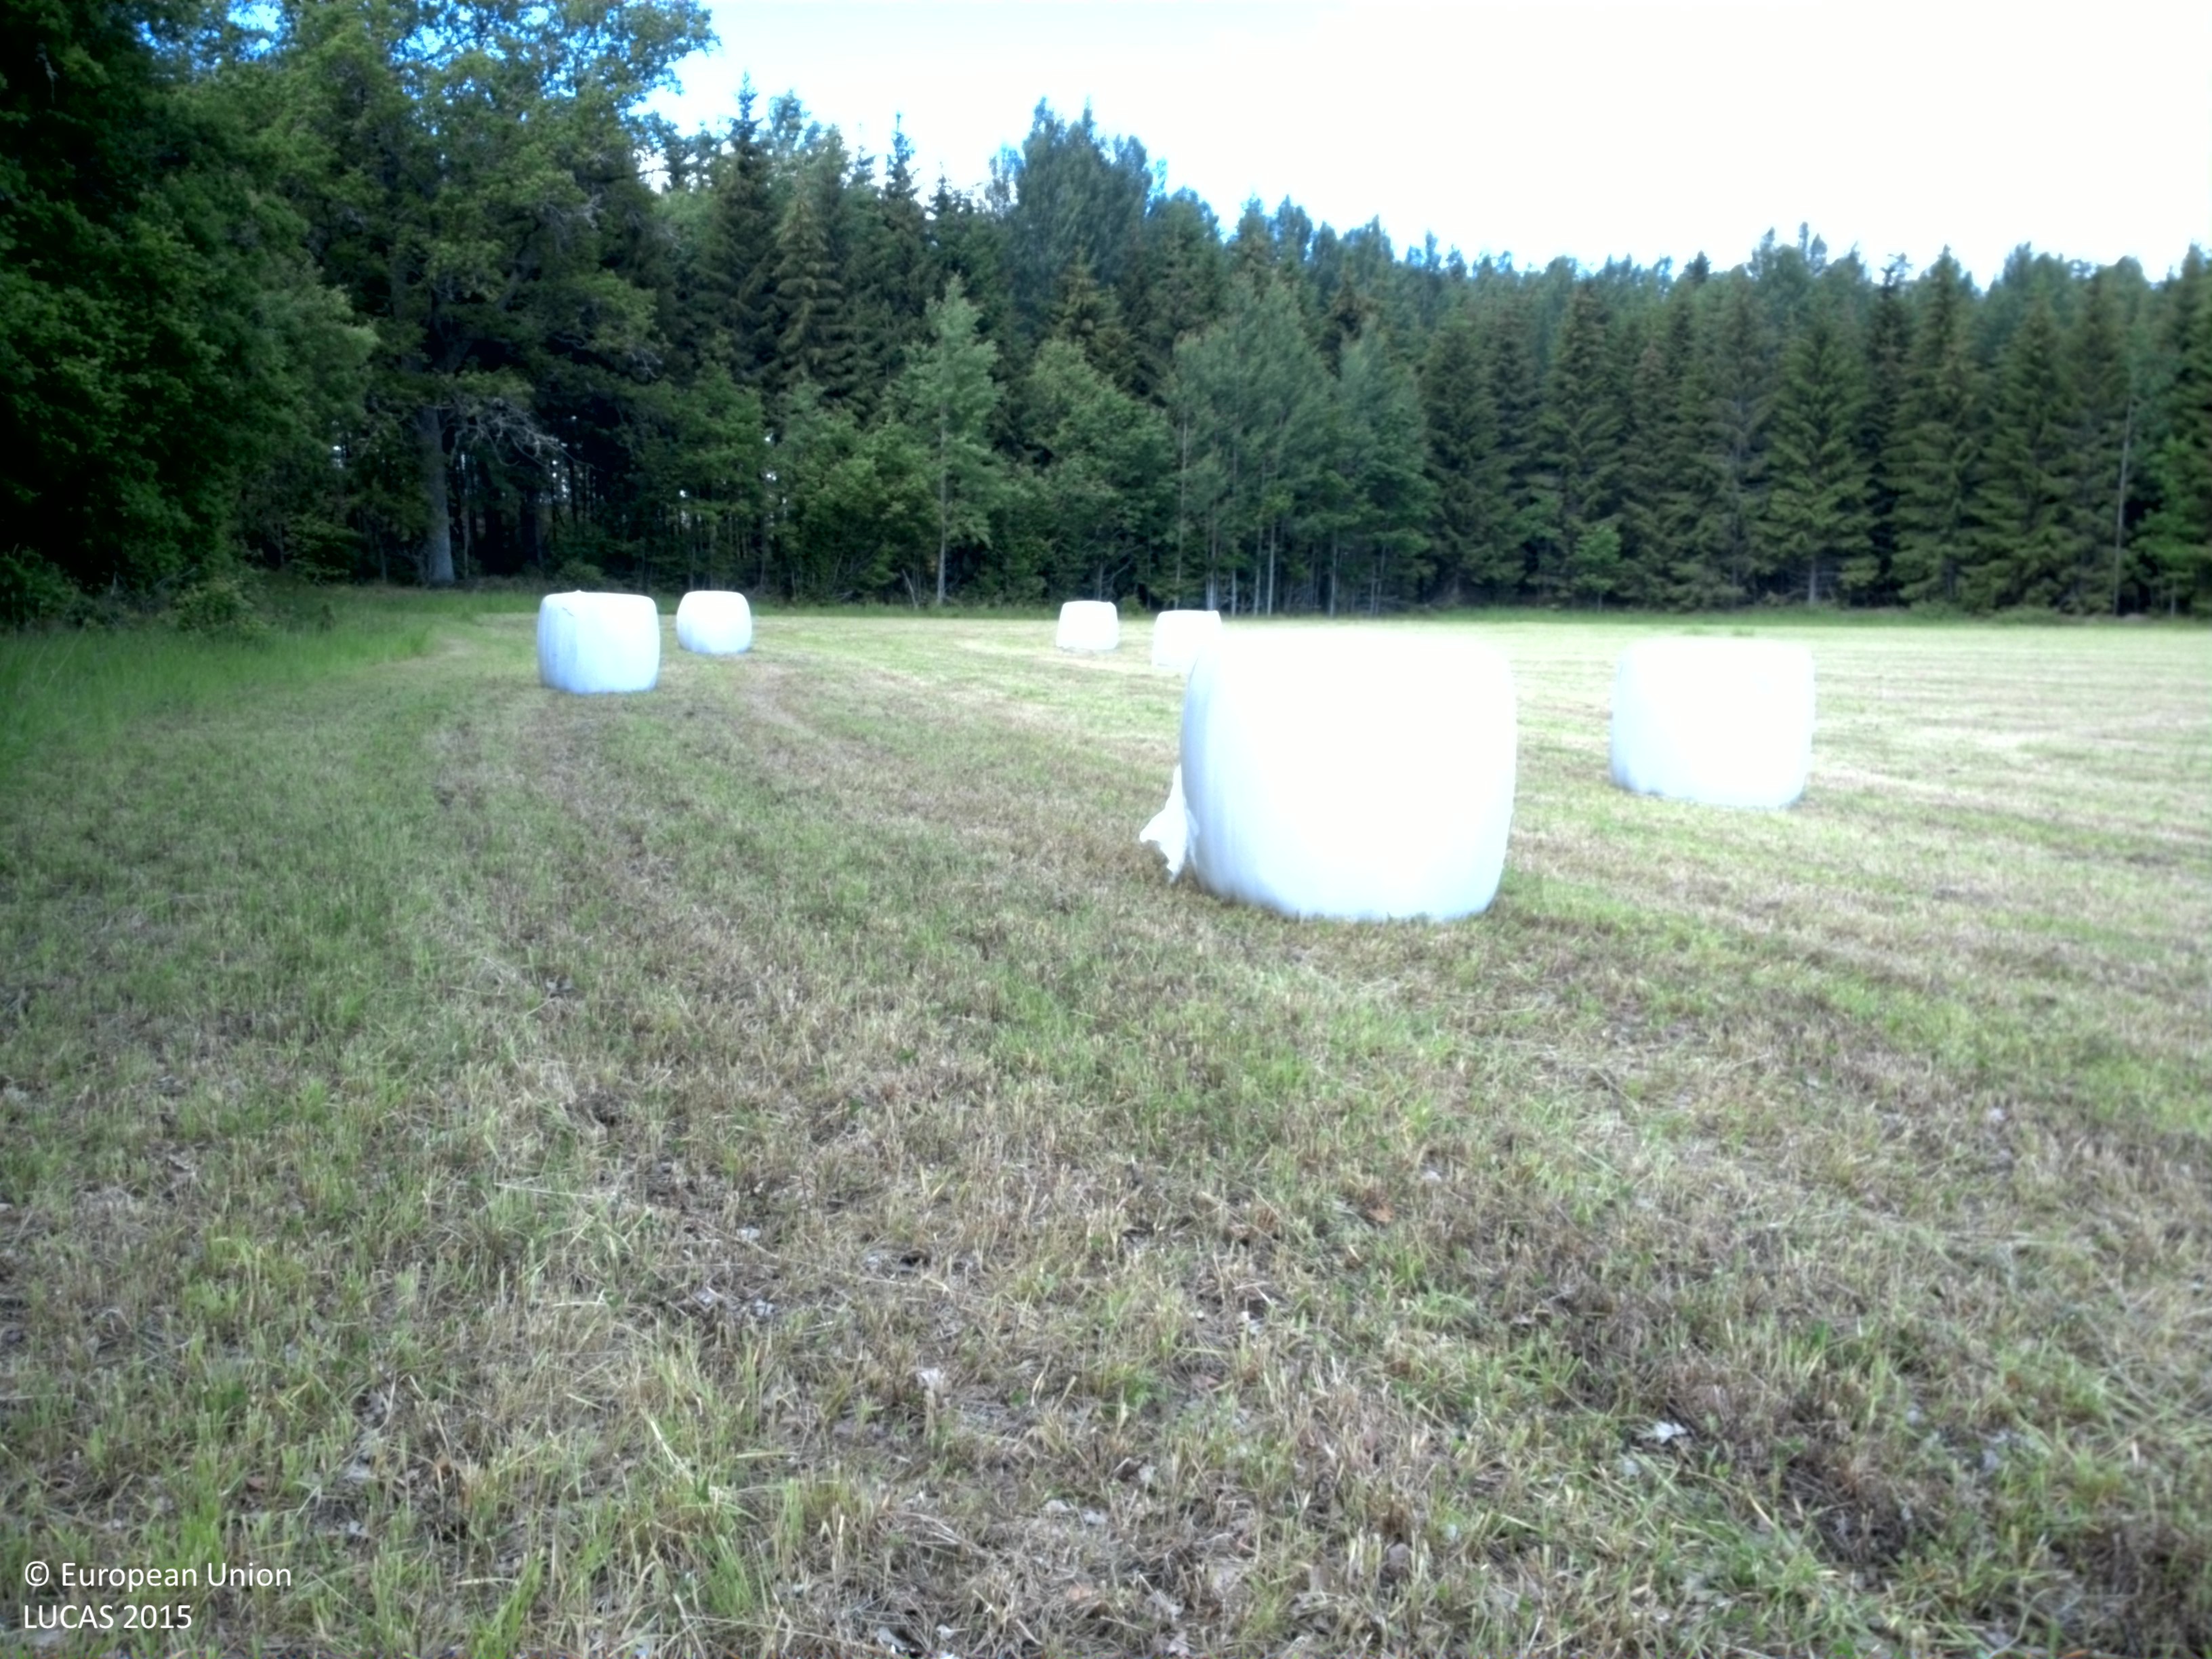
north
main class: Cropland
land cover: Temporary grasslands
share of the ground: > 75 %
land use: Agriculture (excluding fallow land and kitchen gardens)
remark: Harvested field
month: June
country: SE
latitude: 58.4468
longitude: 16.3867
